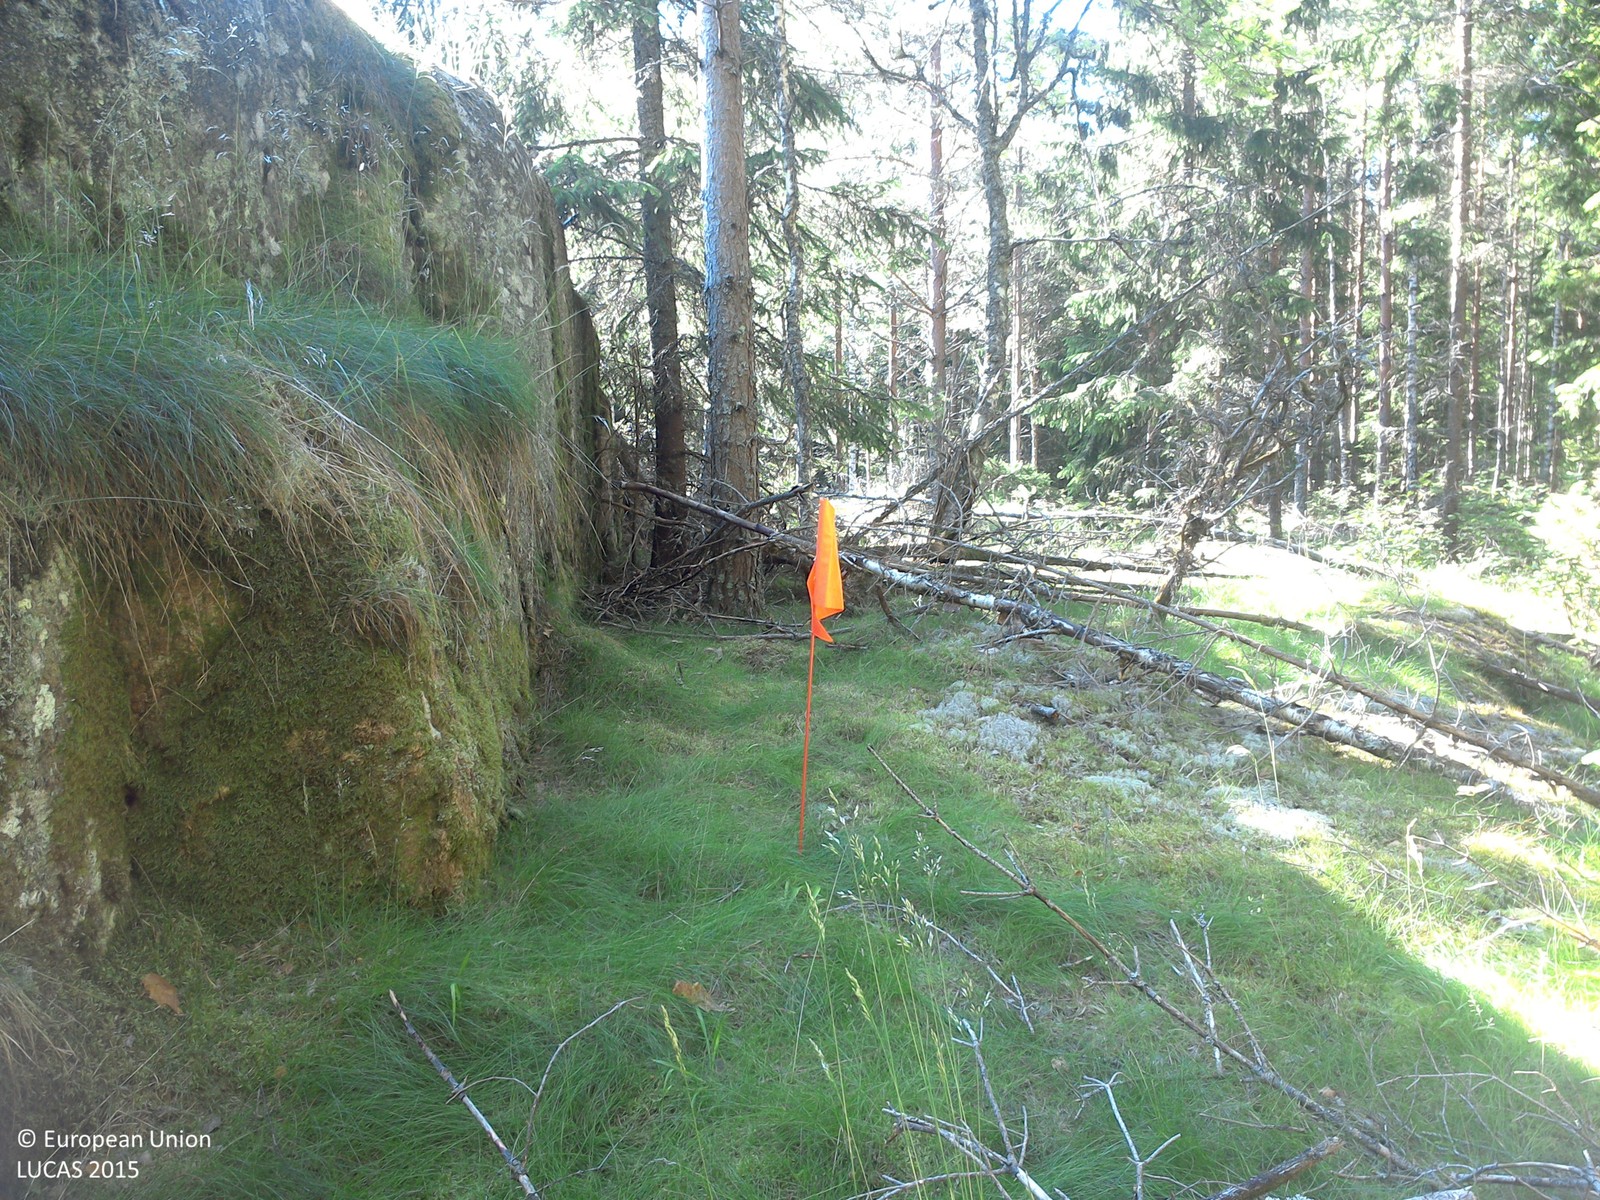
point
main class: Woodland
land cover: Spruce dominated coniferous woodland
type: boreal forest
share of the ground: 50 - 75 %
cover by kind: coniferous forest trees 65 %, lichens and mosses 20 %, herbaceous plants 15 %
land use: Forestry
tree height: > 5 m
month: June
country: SE
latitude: 57.9906
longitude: 15.6962
